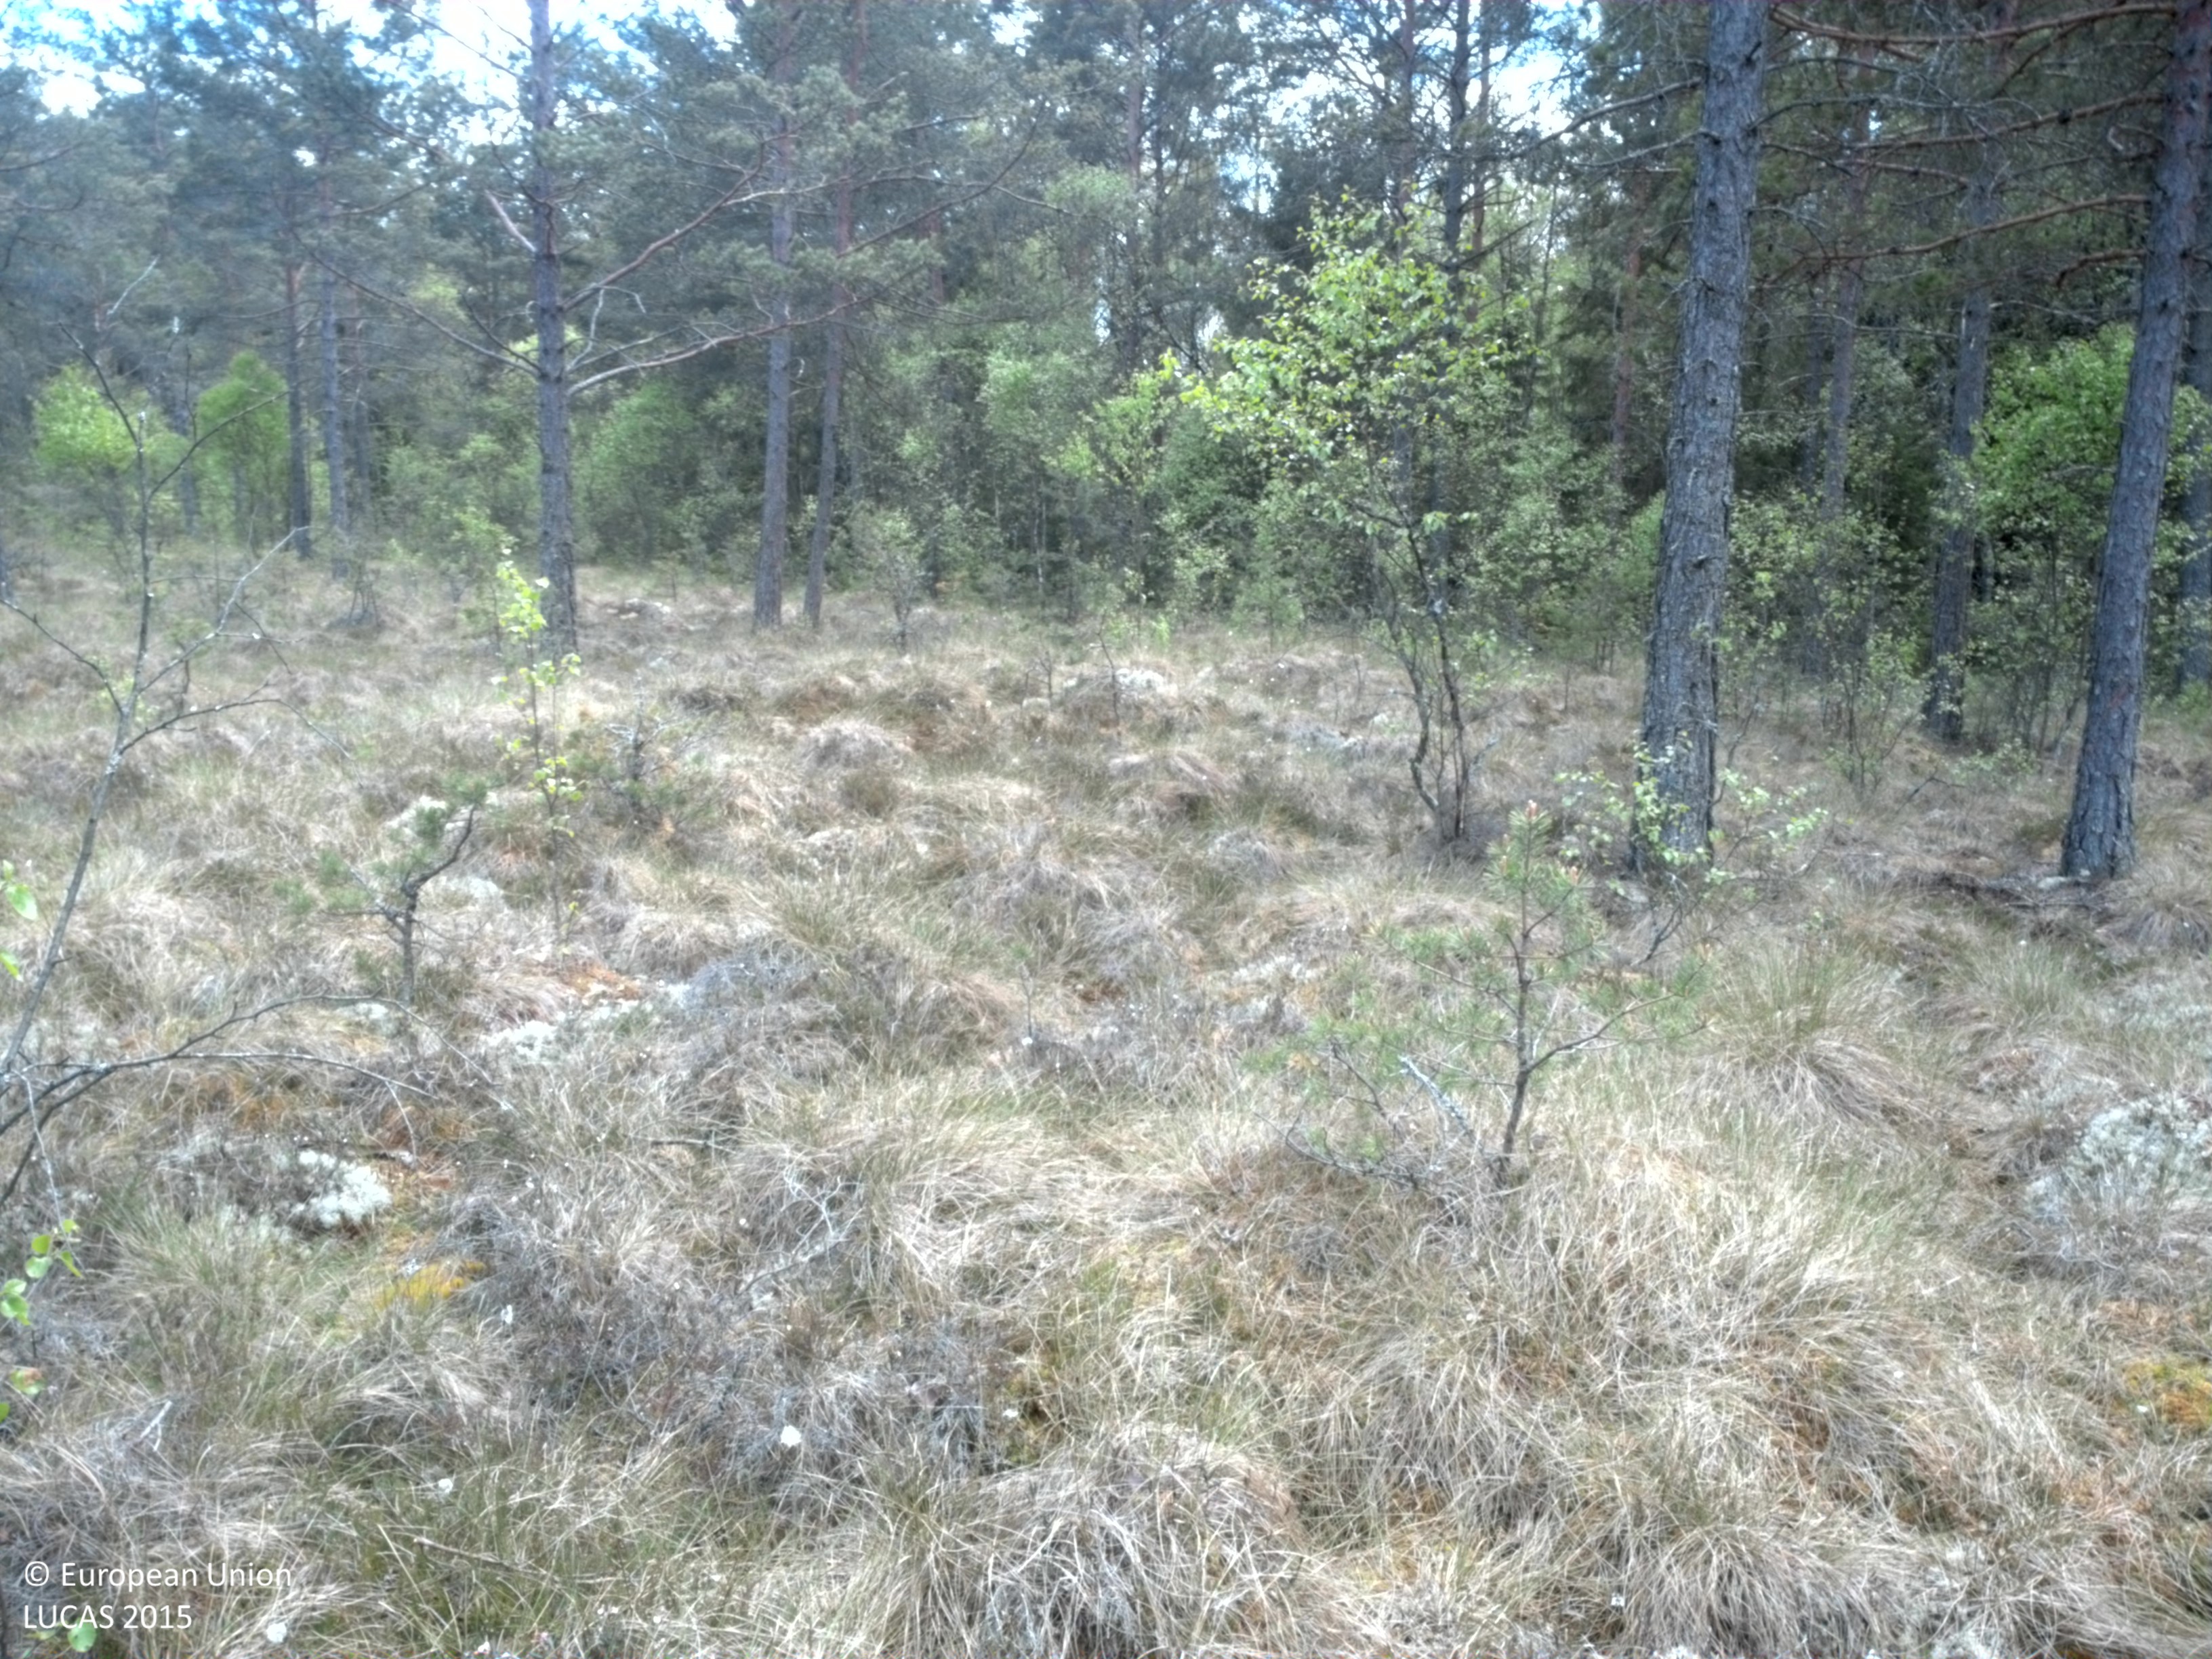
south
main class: Woodland
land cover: Pine dominated coniferous woodland
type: mire and swamp forests
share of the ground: > 75 %
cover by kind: coniferous forest trees 50 %, herbaceous plants 25 %, lichens and mosses 25 %
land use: Semi-natural and natural areas not in use
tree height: > 5 m
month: May
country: SE
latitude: 56.5757
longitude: 15.0279
